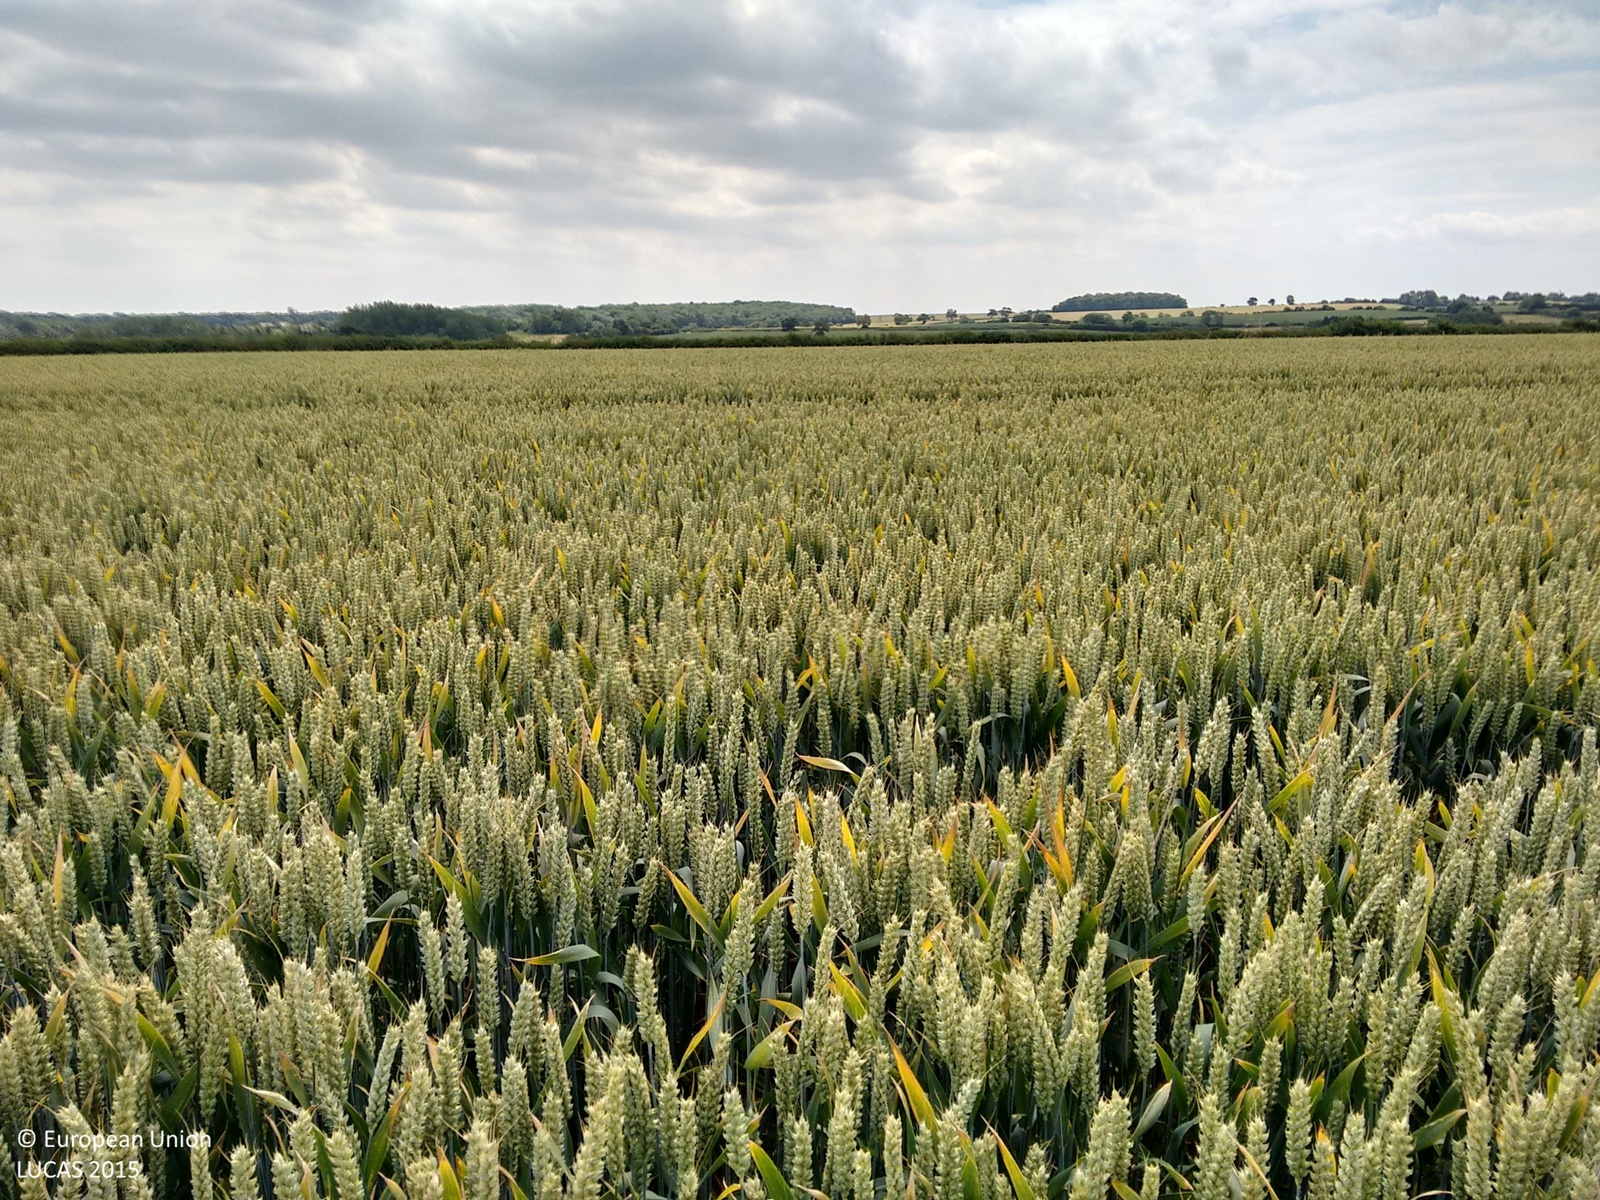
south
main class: Cropland
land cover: Common wheat
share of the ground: > 75 %
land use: Agriculture (excluding fallow land and kitchen gardens)
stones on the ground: < 10 %
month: July
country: GB
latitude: 52.4690
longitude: -0.7427
